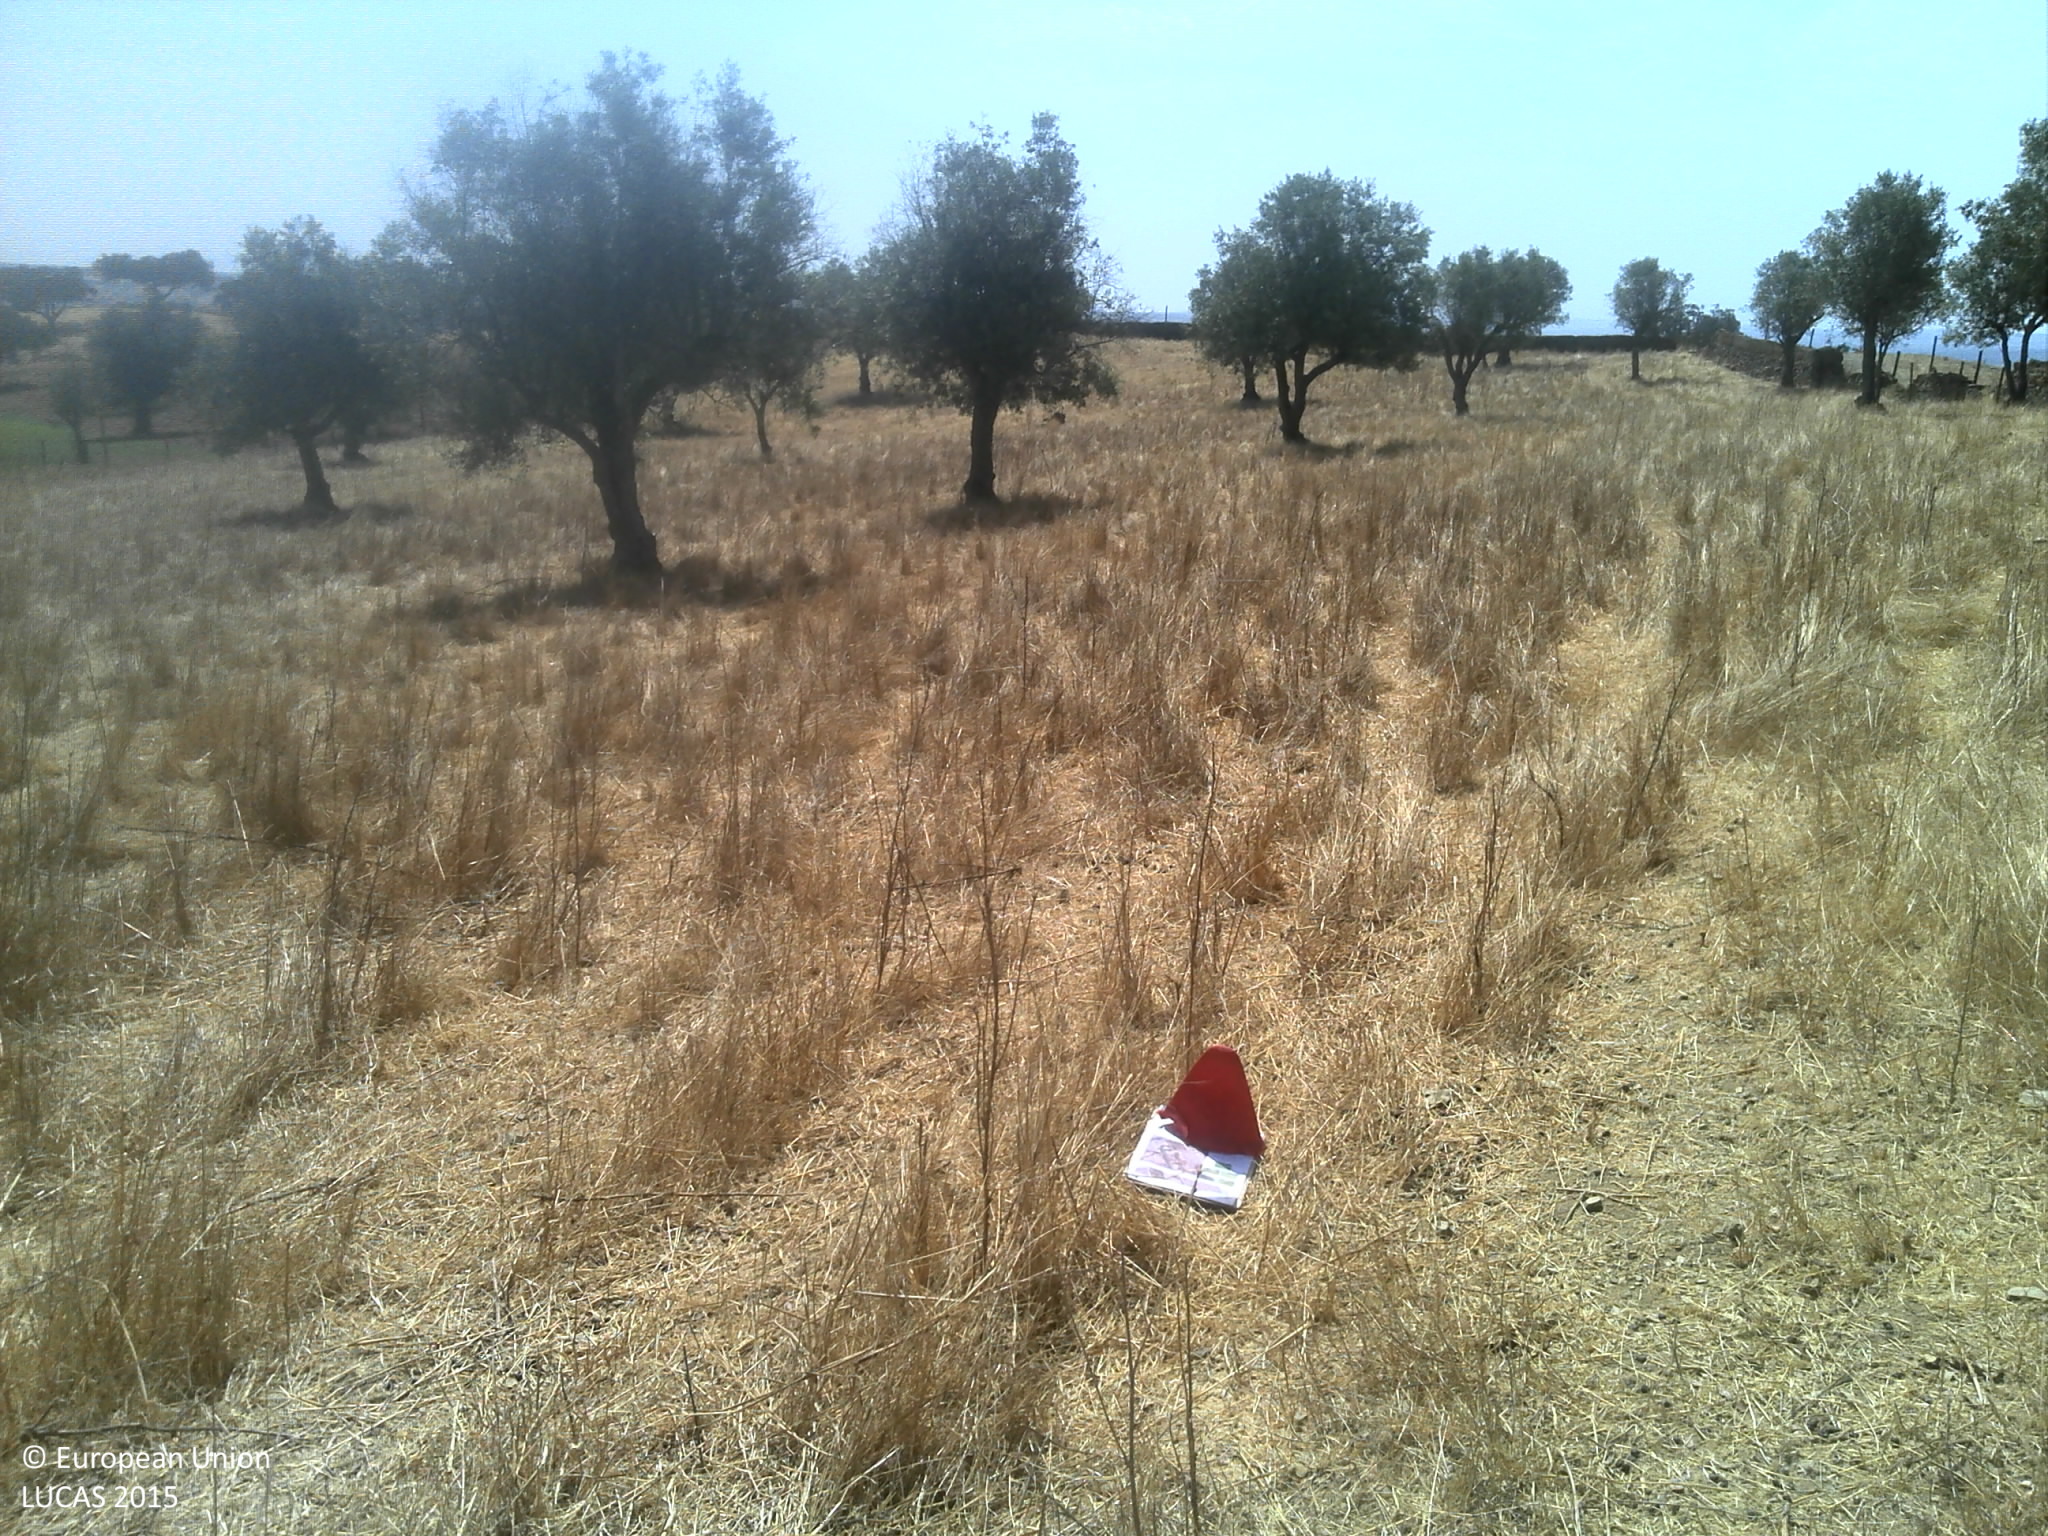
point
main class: Cropland
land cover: Olive groves
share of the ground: 25 - 50 %
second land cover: Grassland without tree/shrub cover
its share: 50 - 75 %
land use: Agriculture (excluding fallow land and kitchen gardens)
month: August
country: PT
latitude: 37.5950
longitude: -8.2517
